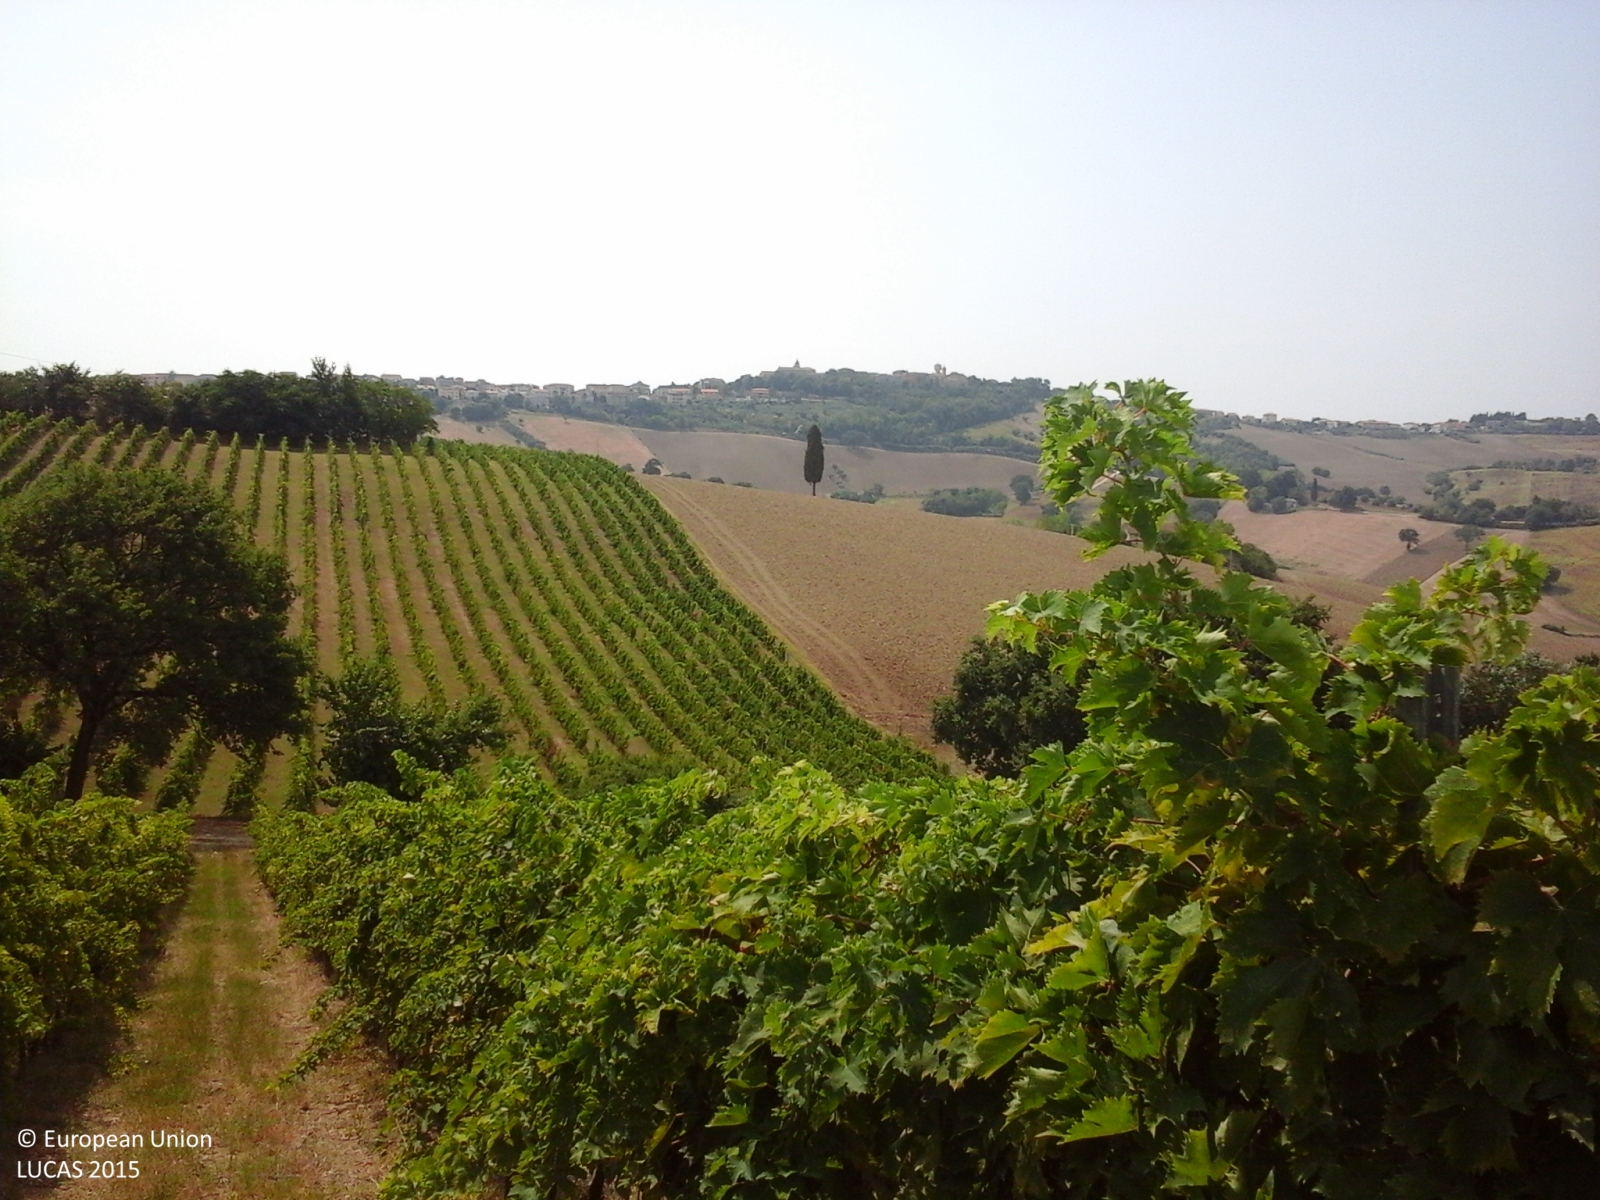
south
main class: Cropland
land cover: Vineyards
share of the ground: > 75 %
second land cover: Spontaneously vegetated surfaces
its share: 50 - 75 %
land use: Agriculture (excluding fallow land and kitchen gardens)
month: August
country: IT
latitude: 43.4269
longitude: 13.4378
